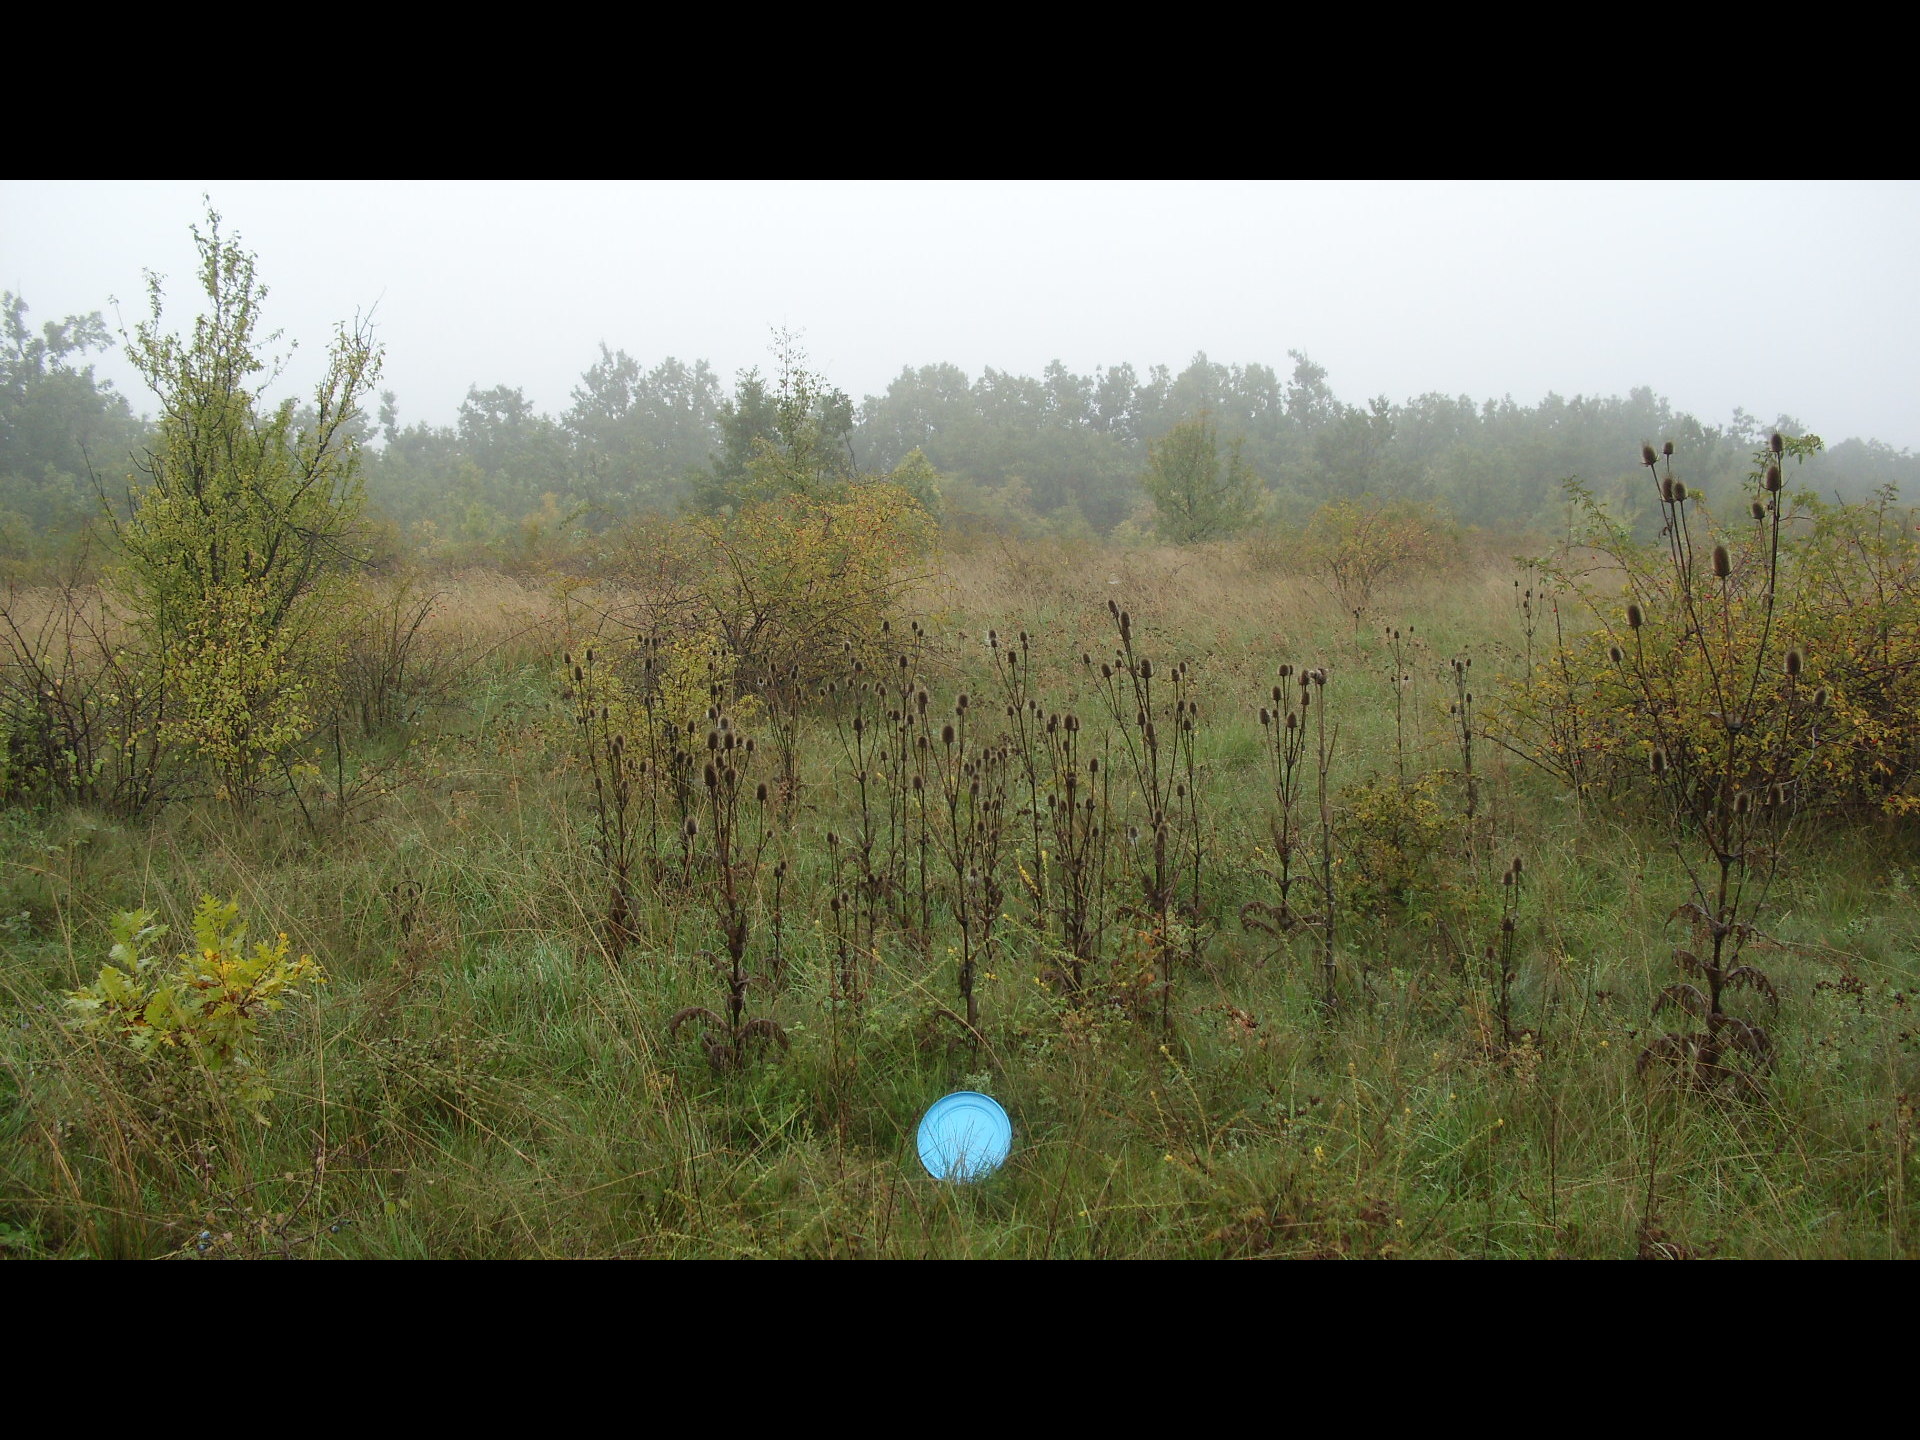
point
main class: Grassland
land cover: Grassland with sparse tree/shrub cover
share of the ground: > 75 %
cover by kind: herbaceous plants 85 %, shrubs 10 %, broadleaved forest trees 5 %
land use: Semi-natural and natural areas not in use
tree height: < 5 m
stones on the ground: < 10 %
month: October
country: BG
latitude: 43.7923
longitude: 22.4976
